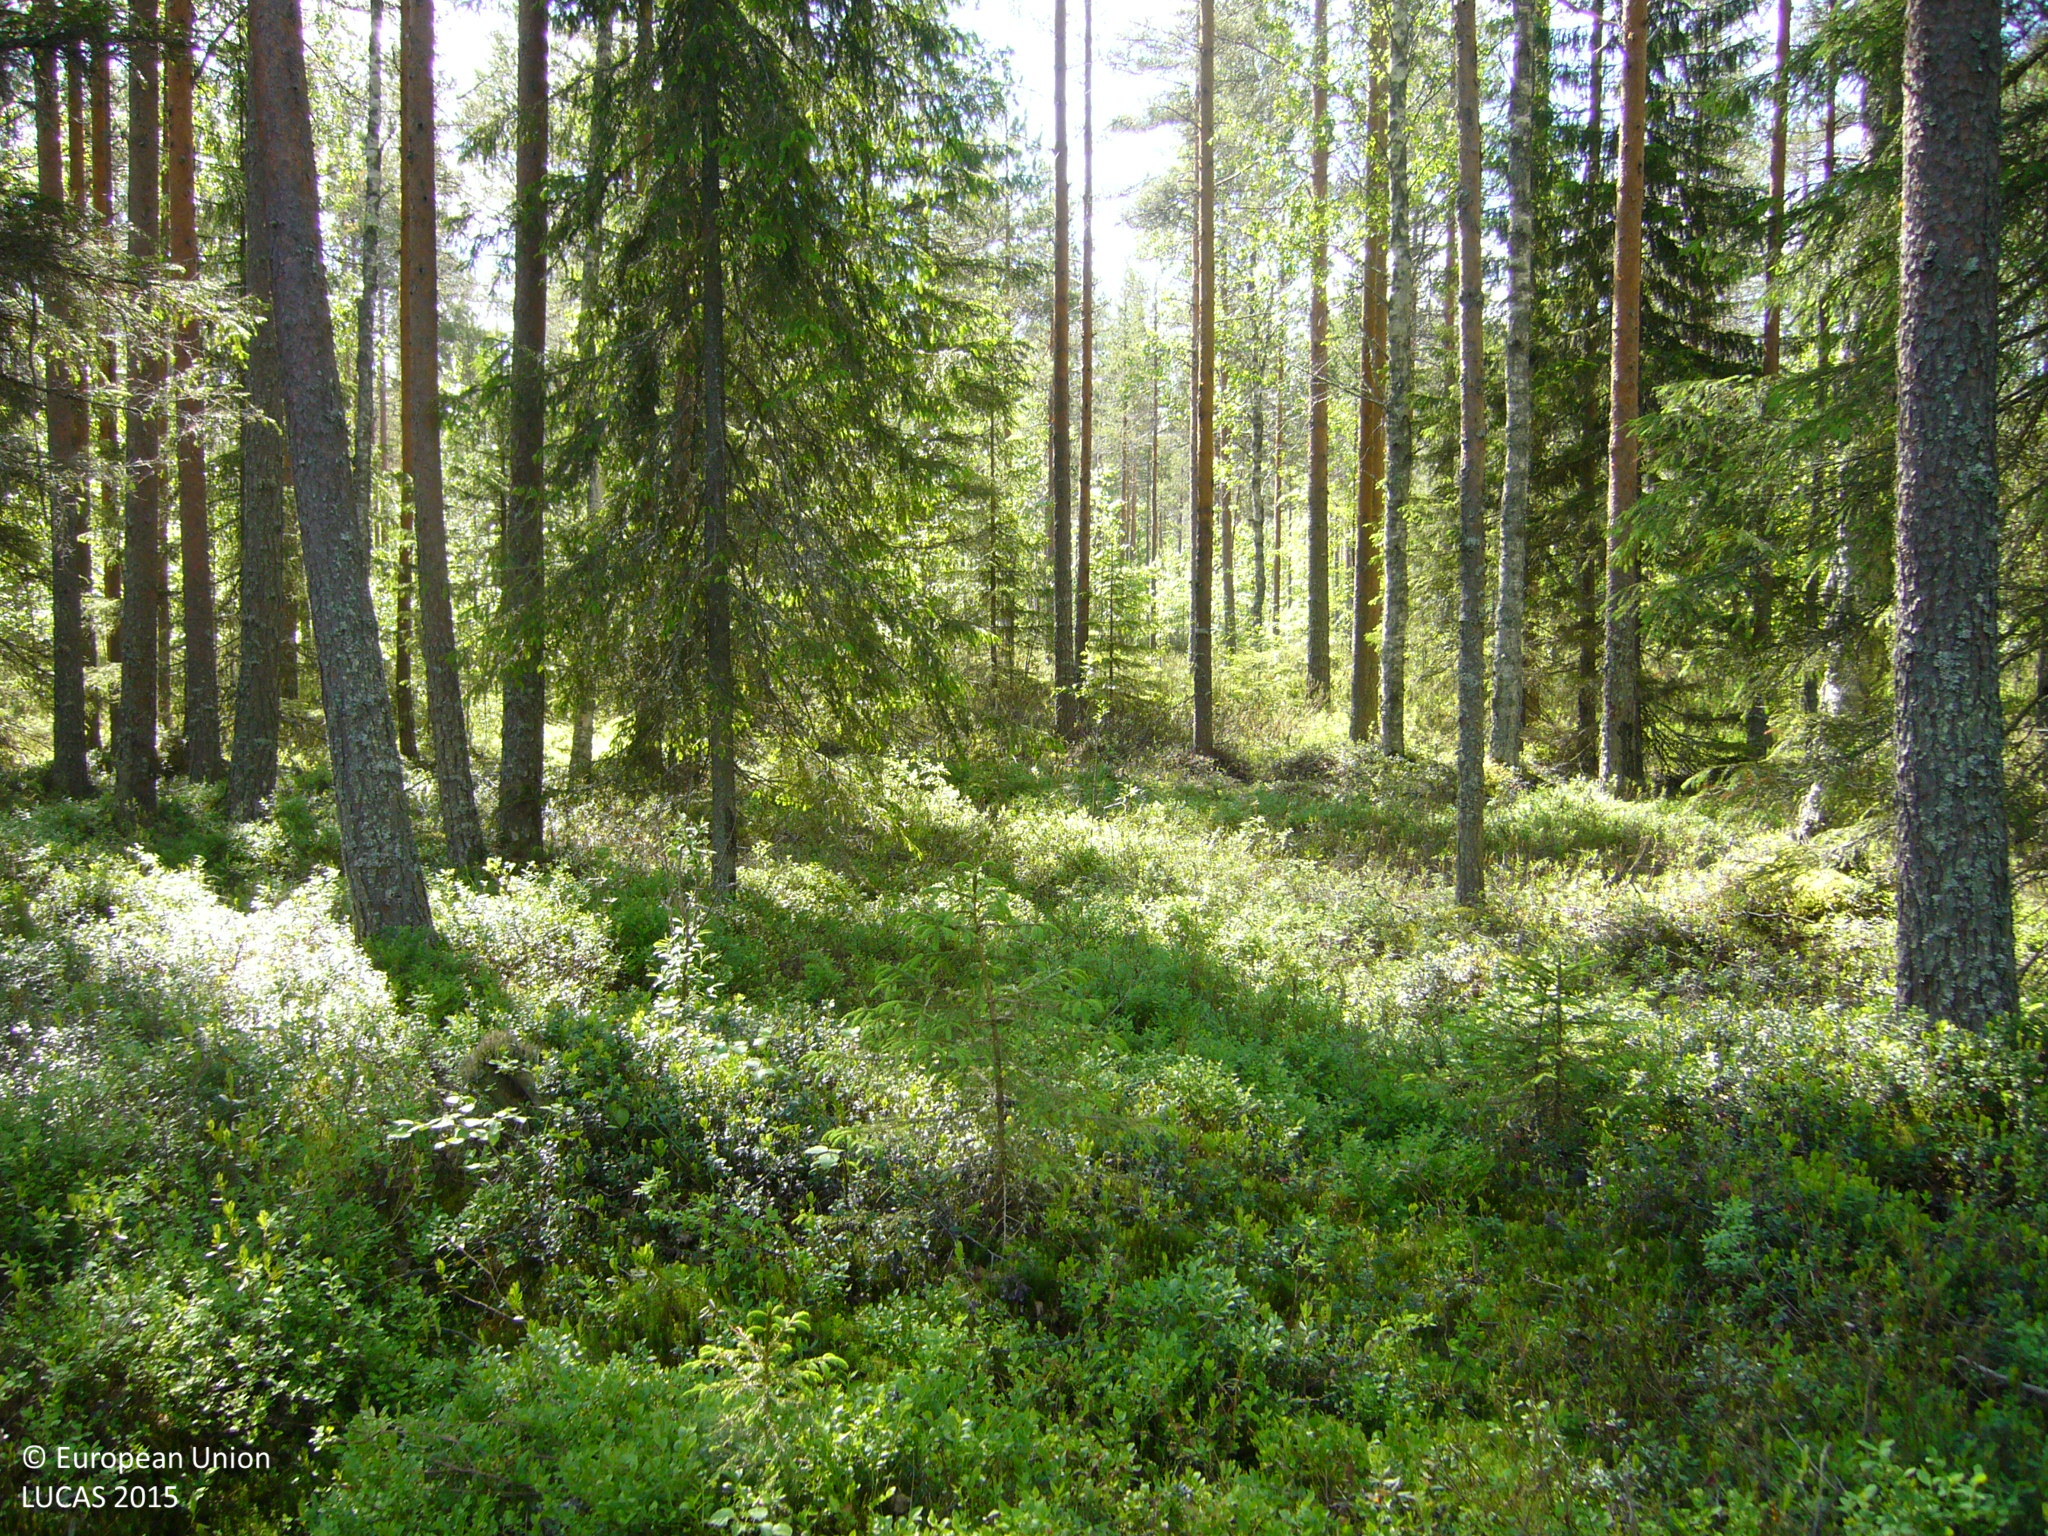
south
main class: Woodland
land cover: Pine dominated mixed woodland
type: boreal forest
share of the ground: > 75 %
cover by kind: coniferous forest trees 60 %, broadleaved forest trees 25 %, shrubs 15 %
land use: Forestry
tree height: > 5 m
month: June
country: FI
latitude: 63.8679
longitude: 26.5877
